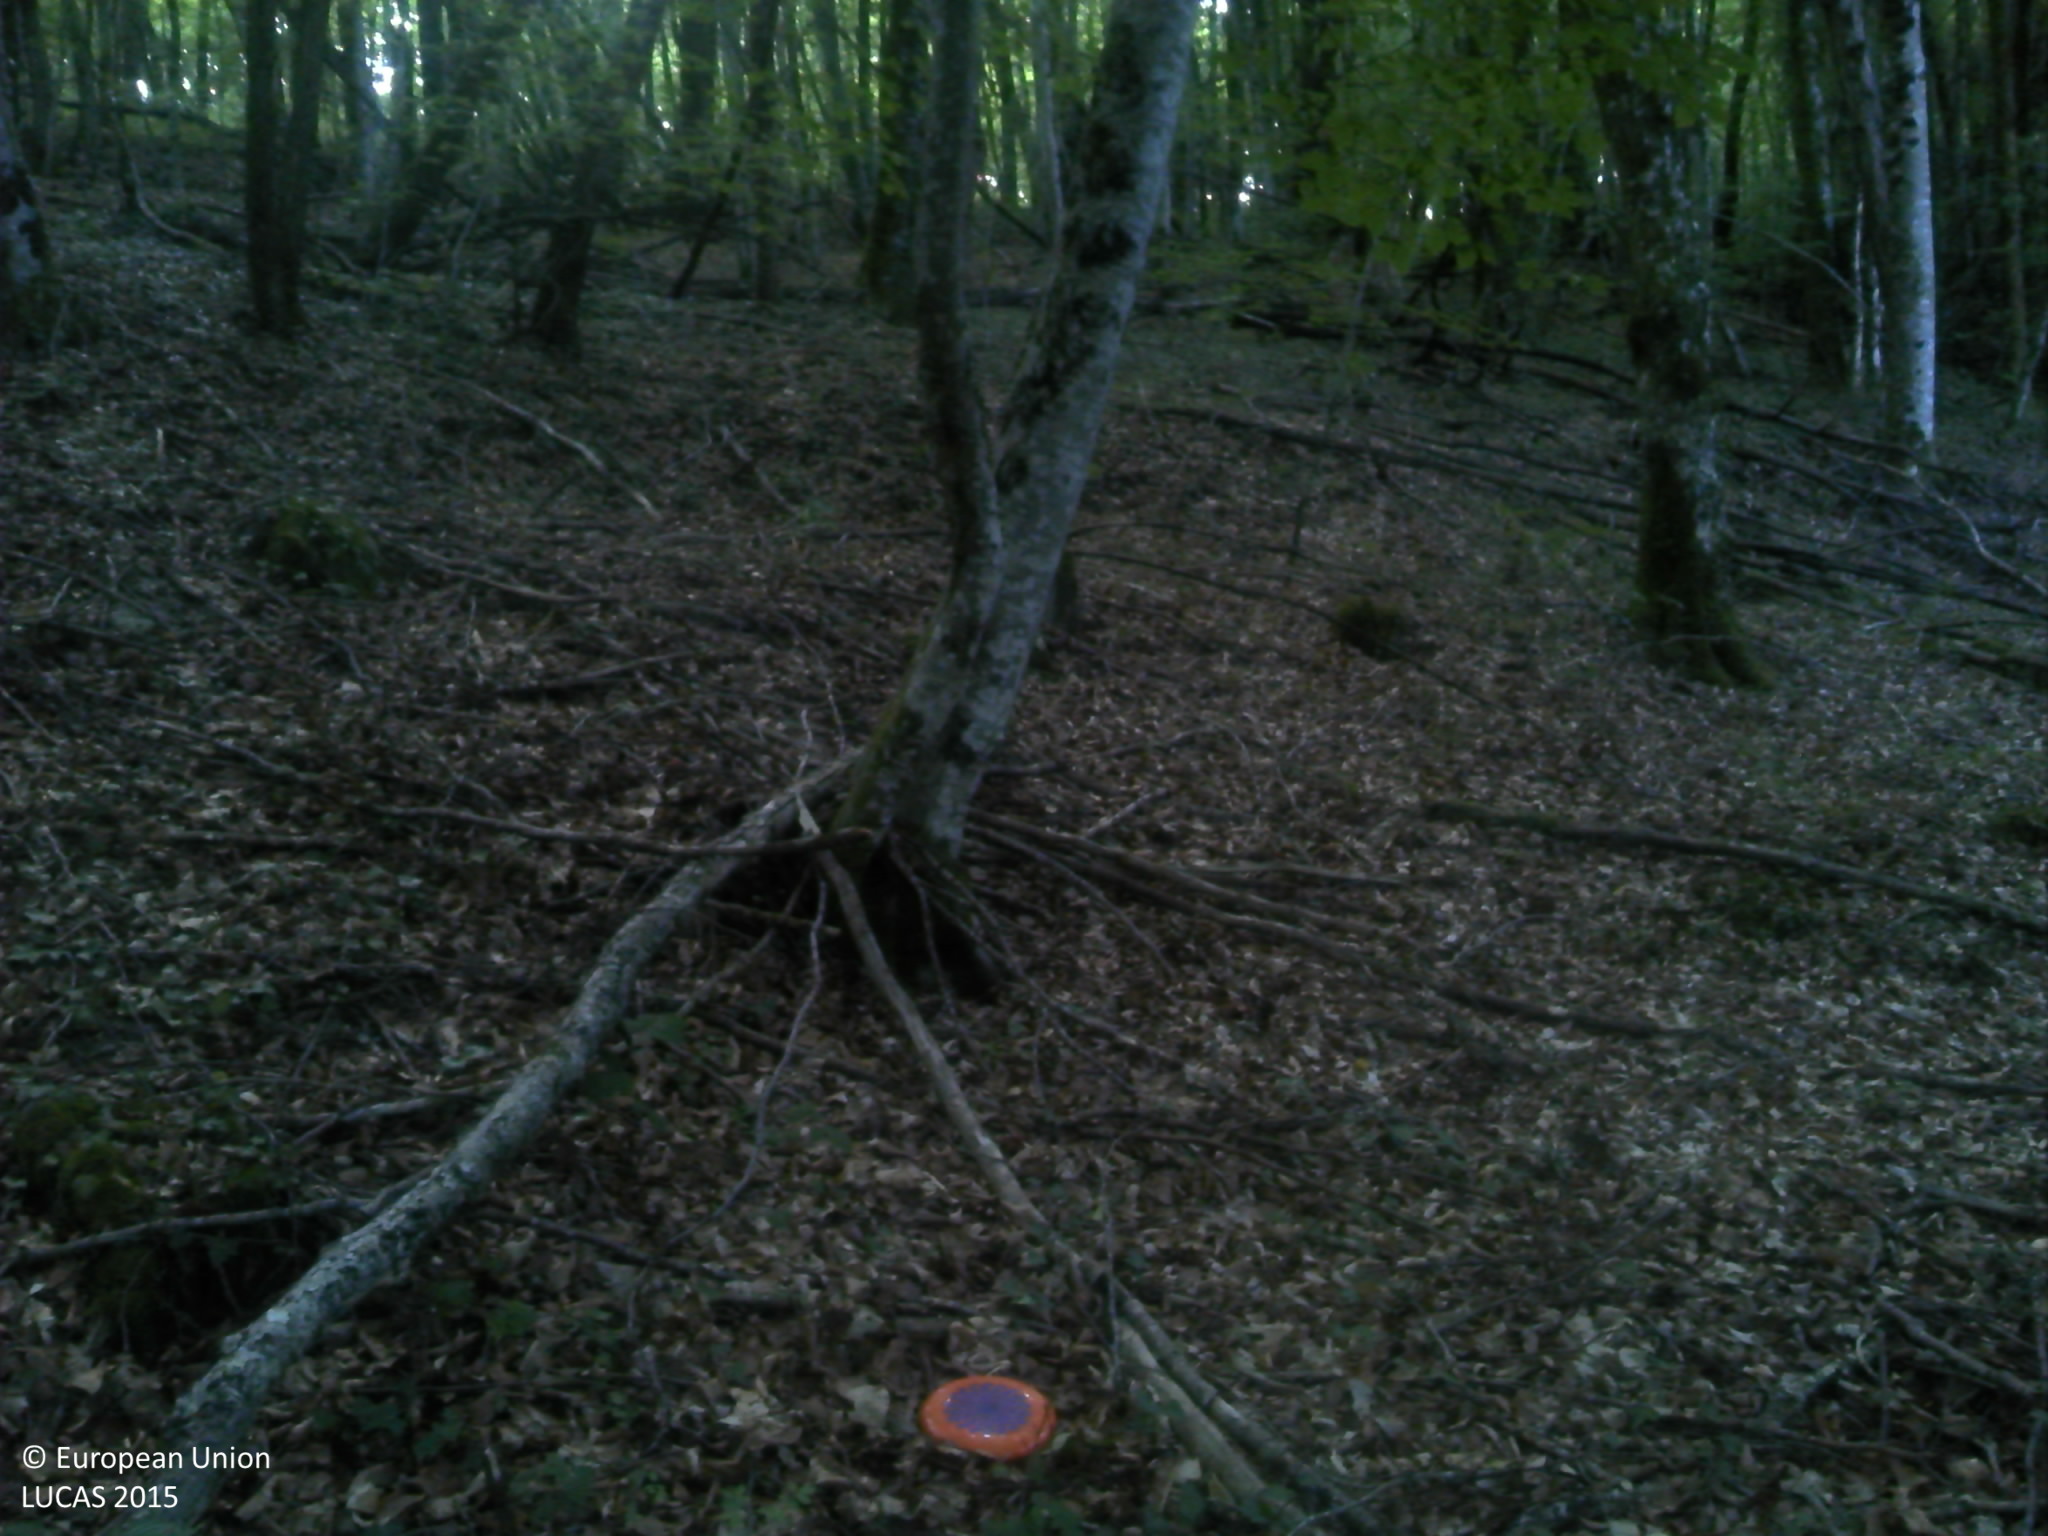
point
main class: Woodland
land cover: Broadleaved woodland
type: acidophilous oak and oak-birch forest
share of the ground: > 75 %
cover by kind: broadleaved forest trees 55 %, unconsolidated bare surface 30 %, lichens and mosses 10 %, herbaceous plants 5 %
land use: Forestry
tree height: > 5 m
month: July
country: FR
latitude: 45.2139
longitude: 1.7066
